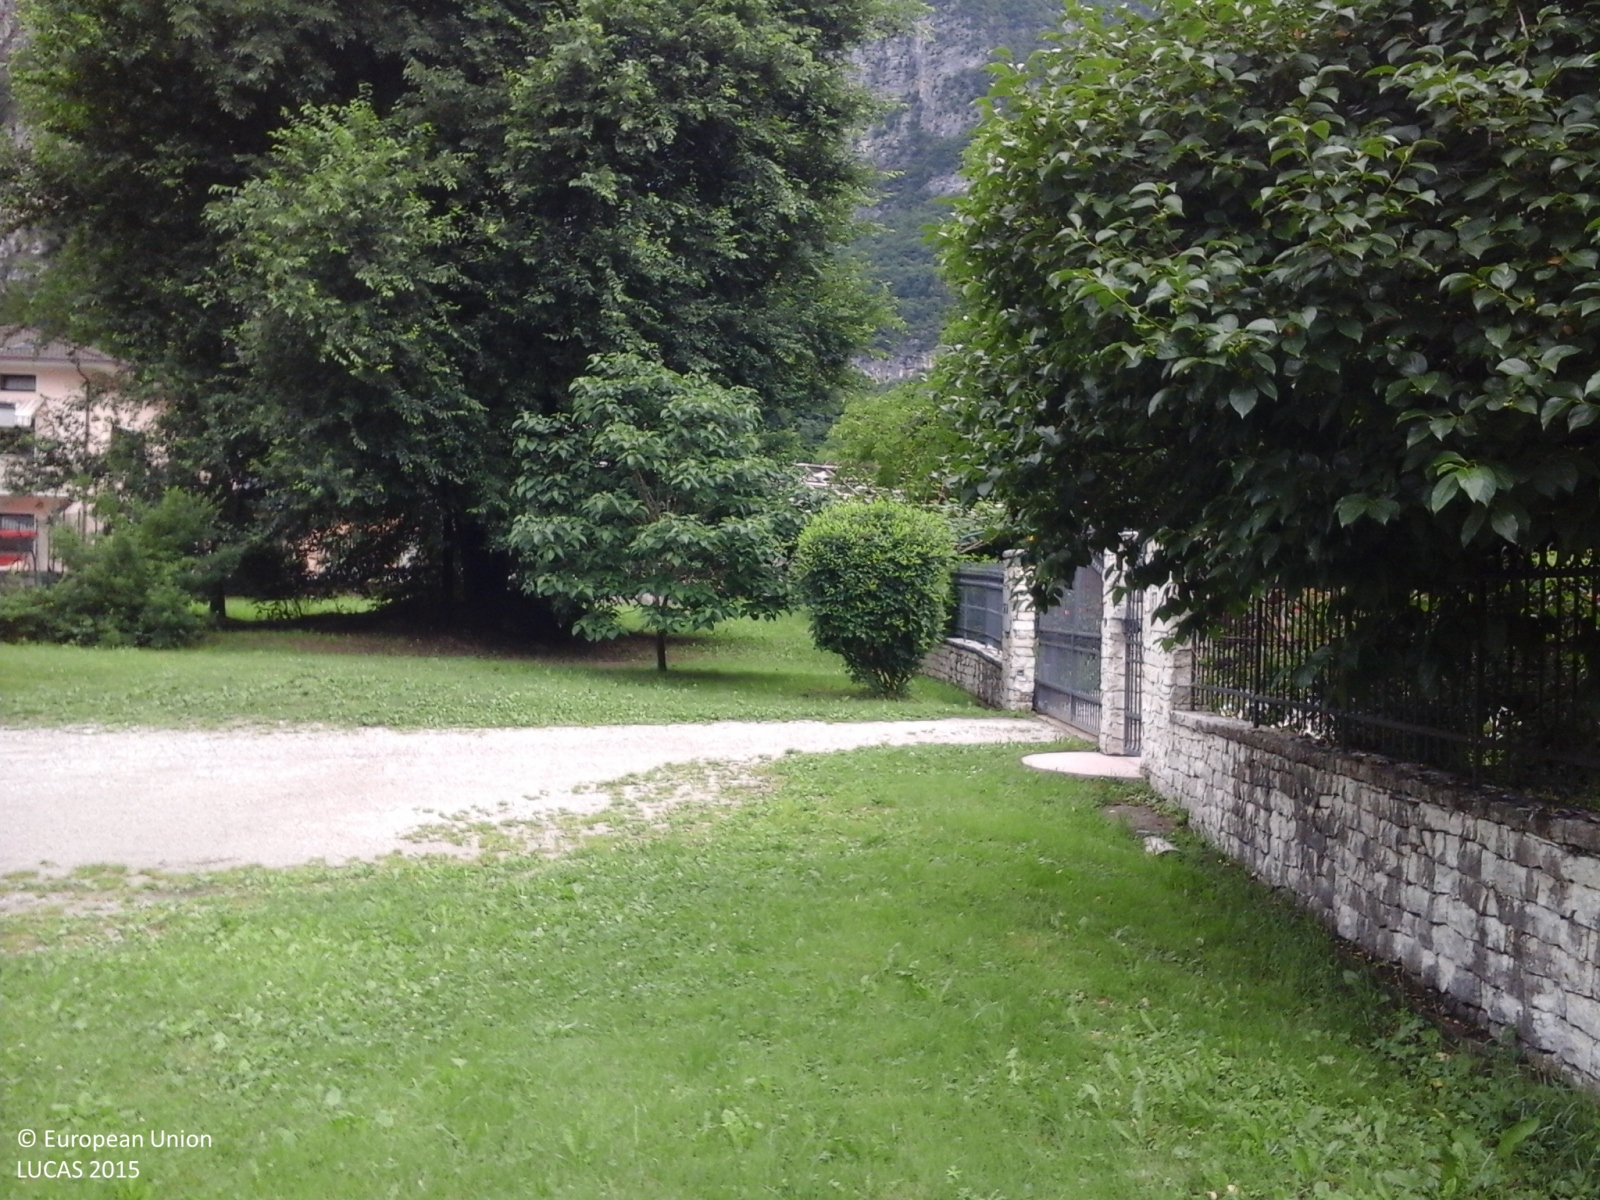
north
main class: Grassland
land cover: Grassland without tree/shrub cover
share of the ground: > 75 %
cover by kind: herbaceous plants 100 %
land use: Residential
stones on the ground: < 10 %
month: June
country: IT
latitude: 46.0144
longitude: 11.6380
